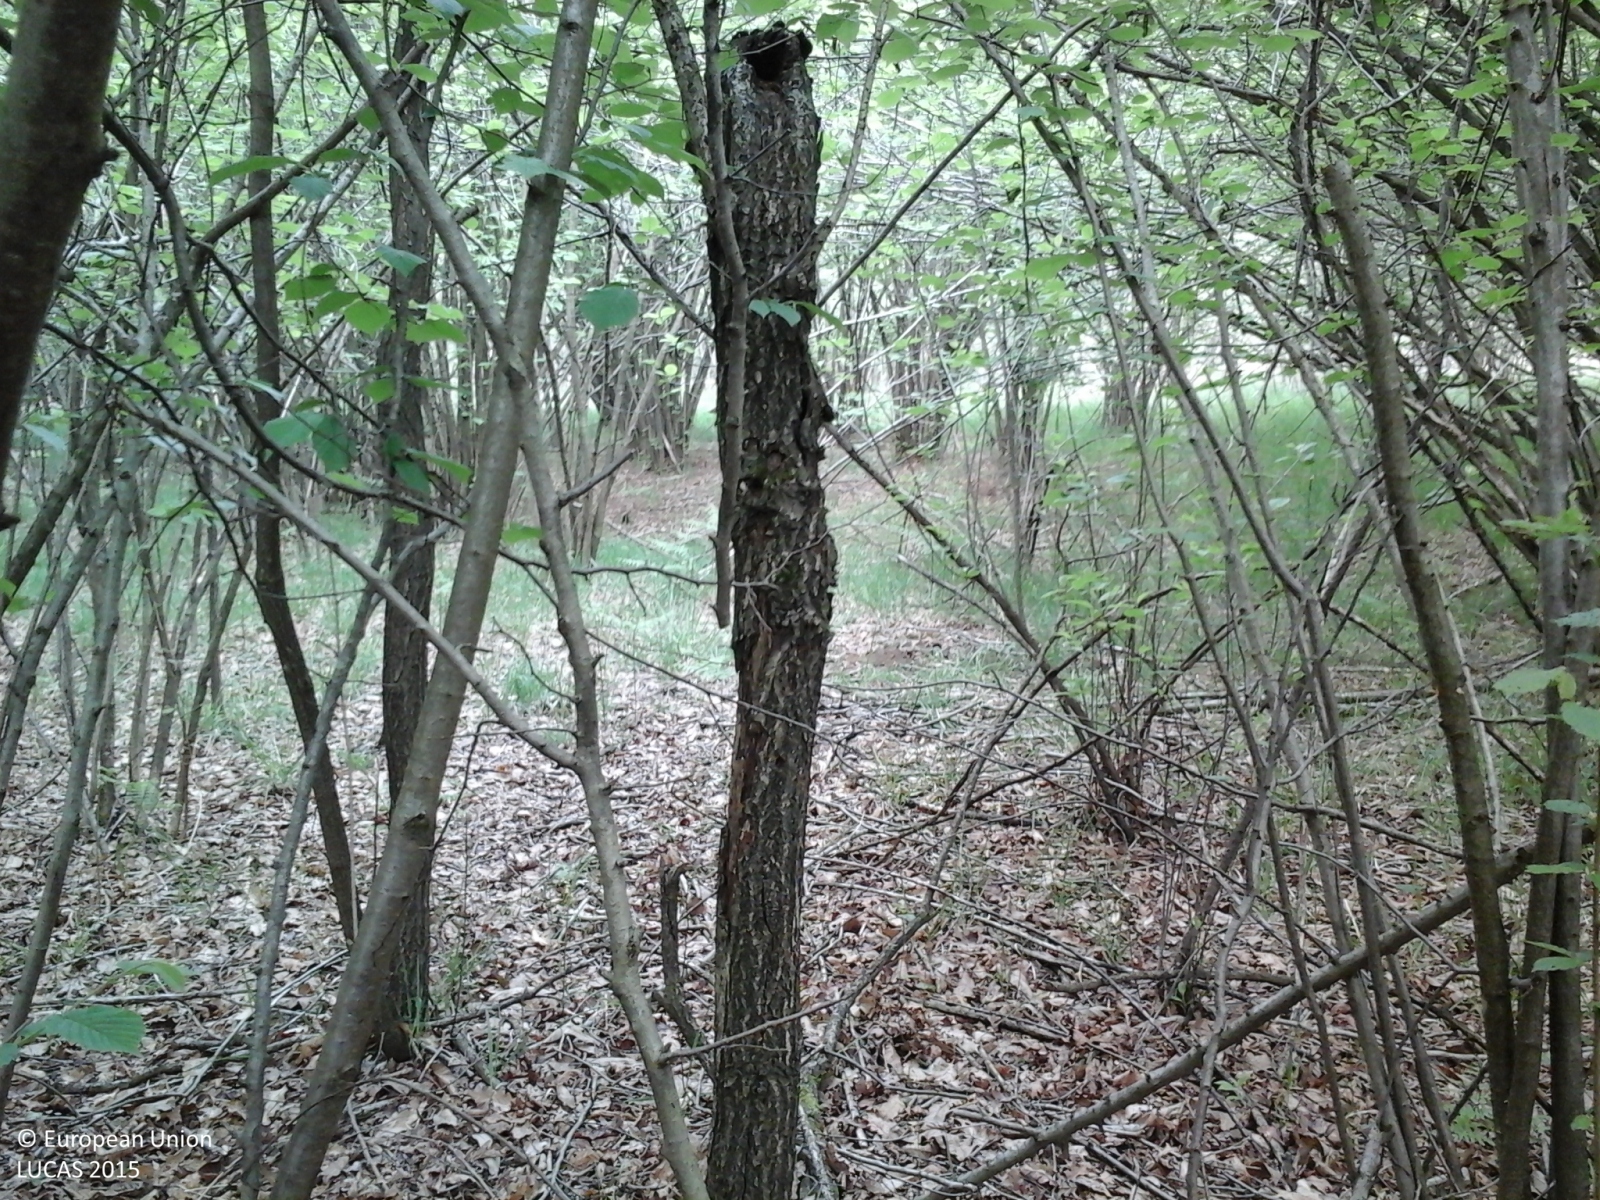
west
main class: Woodland
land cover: Broadleaved woodland
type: mesophytic deciduous forest
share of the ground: > 75 %
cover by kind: broadleaved forest trees 100 %
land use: Forestry
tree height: > 5 m
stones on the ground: < 10 %
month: May
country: IT
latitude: 45.6372
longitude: 8.4502
